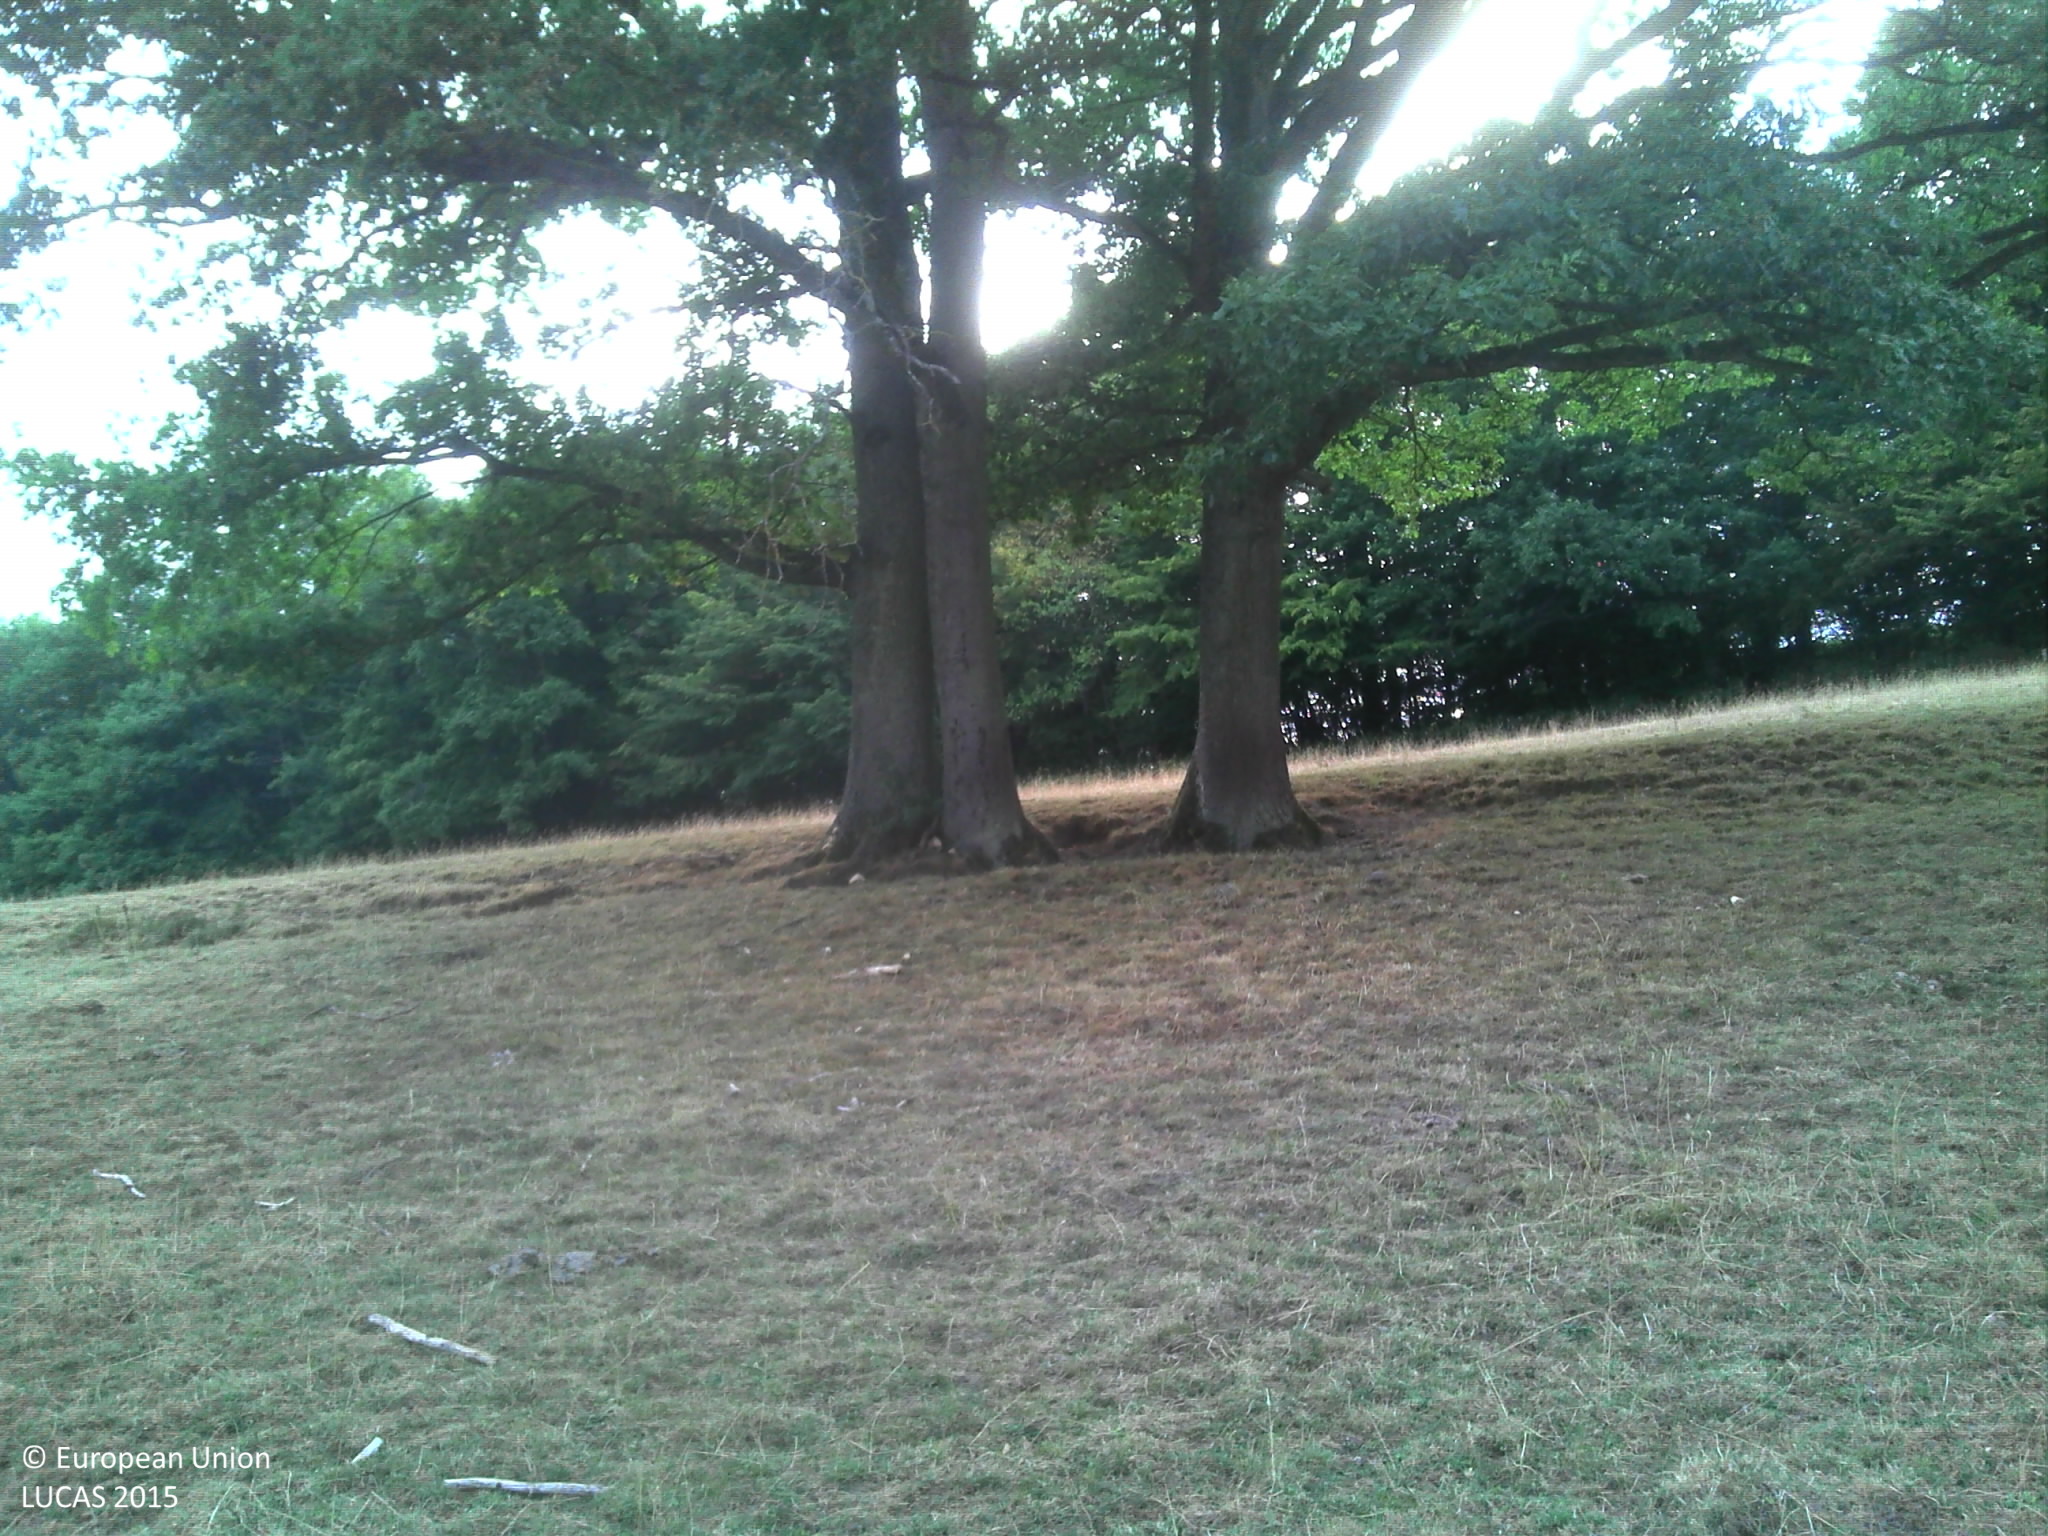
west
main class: Grassland
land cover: Grassland without tree/shrub cover
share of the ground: > 75 %
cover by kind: herbaceous plants 100 %
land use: Agriculture (excluding fallow land and kitchen gardens)
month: August
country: FR
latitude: 46.6582
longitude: 4.4469
